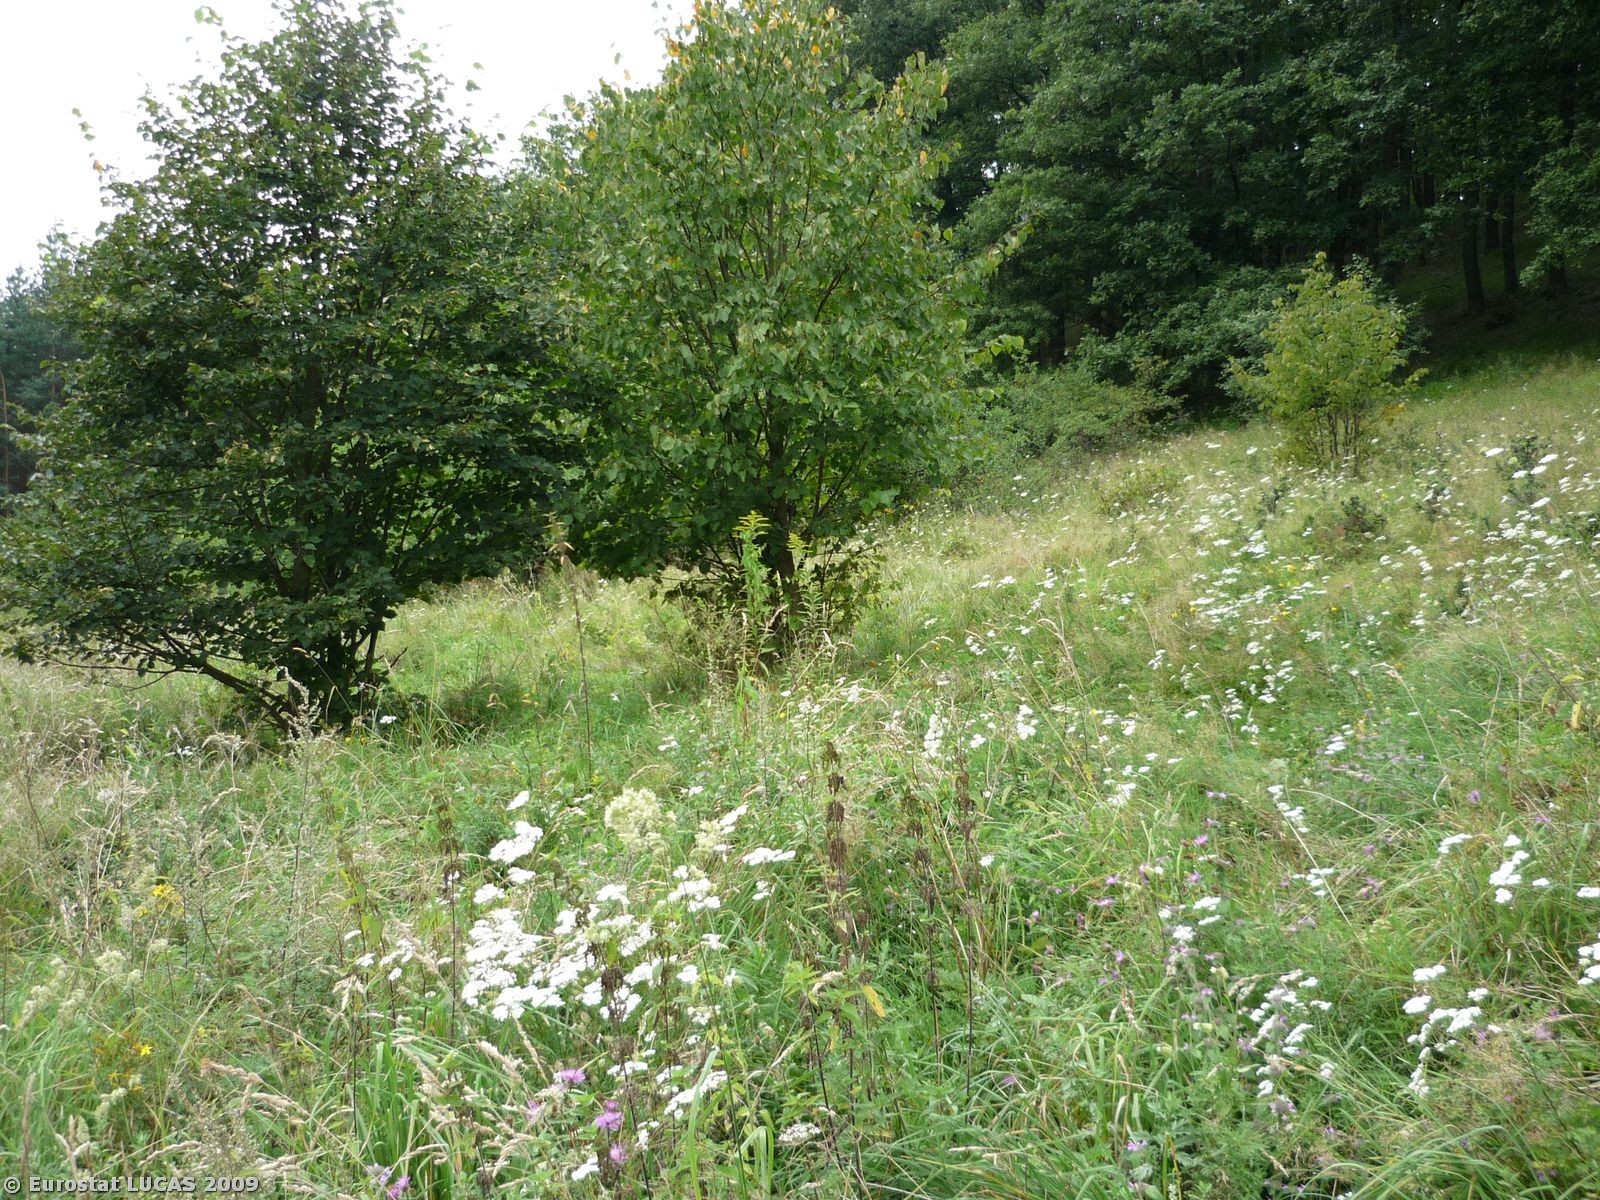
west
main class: Grassland
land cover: Grassland with sparse tree/shrub cover
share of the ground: > 75 %
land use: Nature reserves
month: August
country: PL
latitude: 50.9952
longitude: 16.0902
